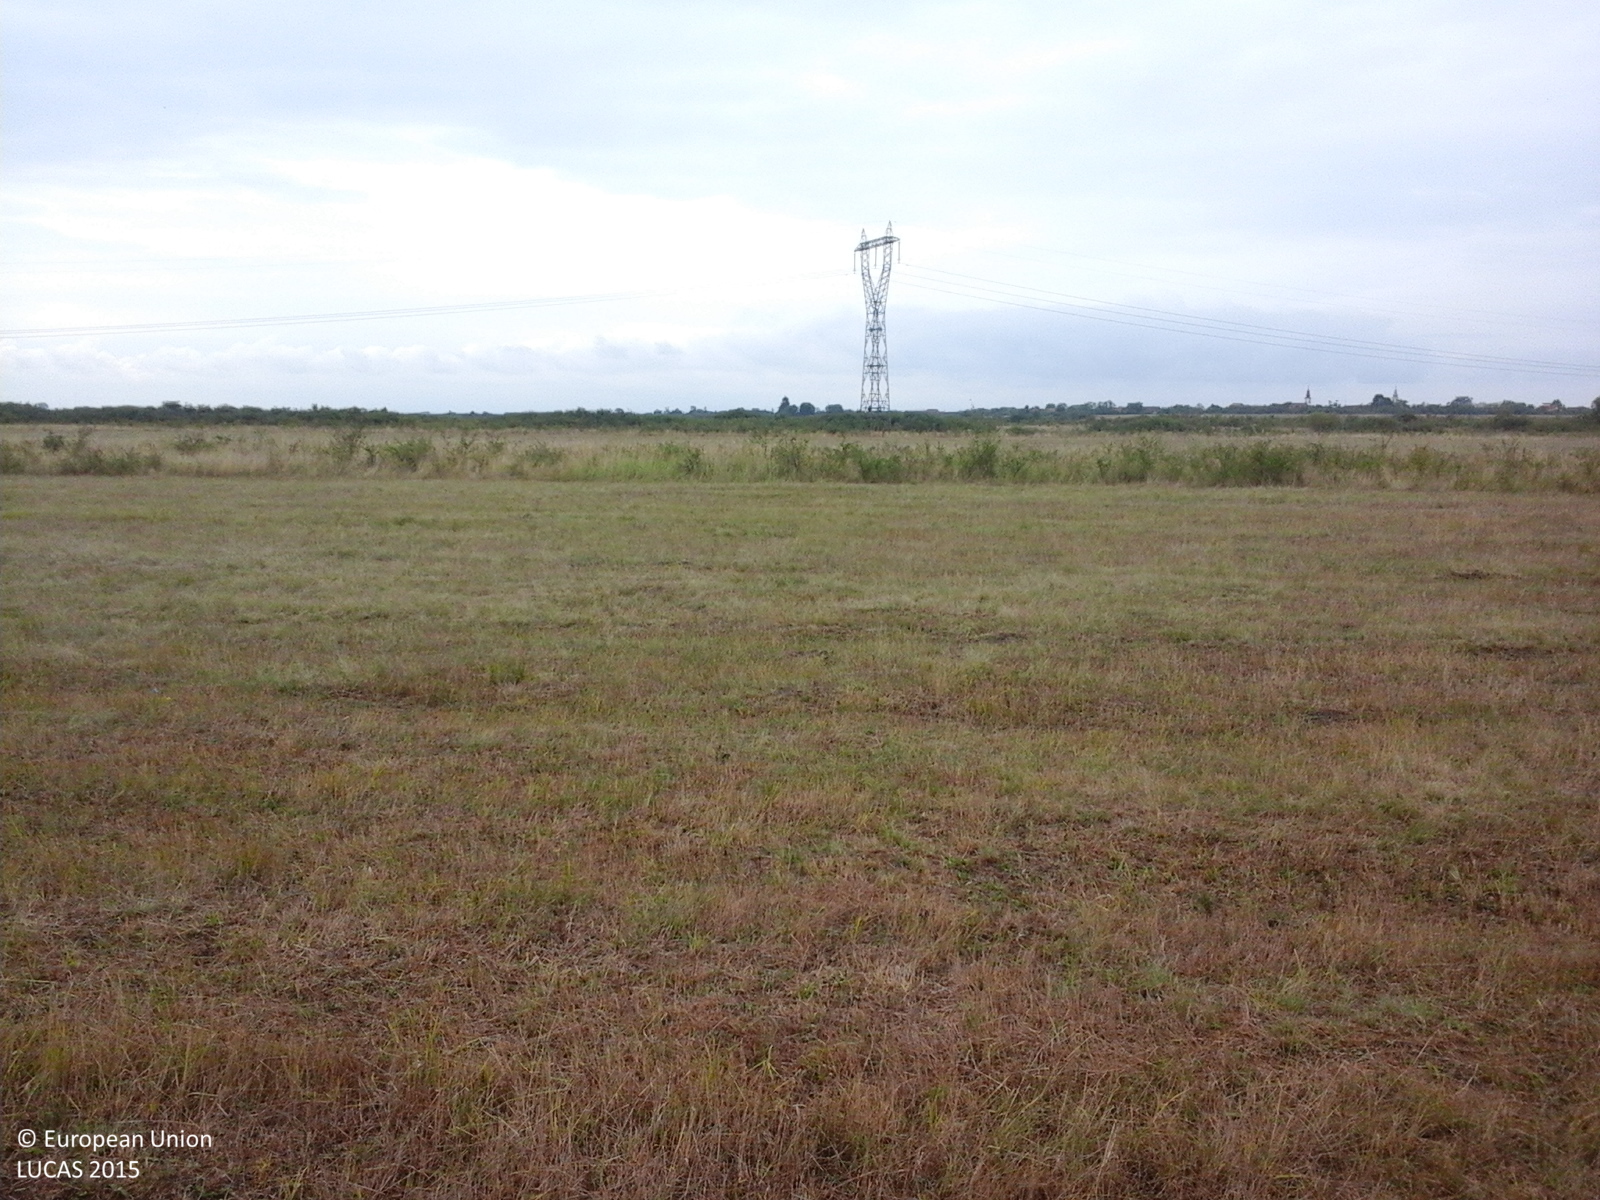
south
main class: Grassland
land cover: Grassland without tree/shrub cover
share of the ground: > 75 %
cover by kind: herbaceous plants 100 %
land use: Agriculture (excluding fallow land and kitchen gardens)
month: August
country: RO
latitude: 45.8120
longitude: 21.7348
